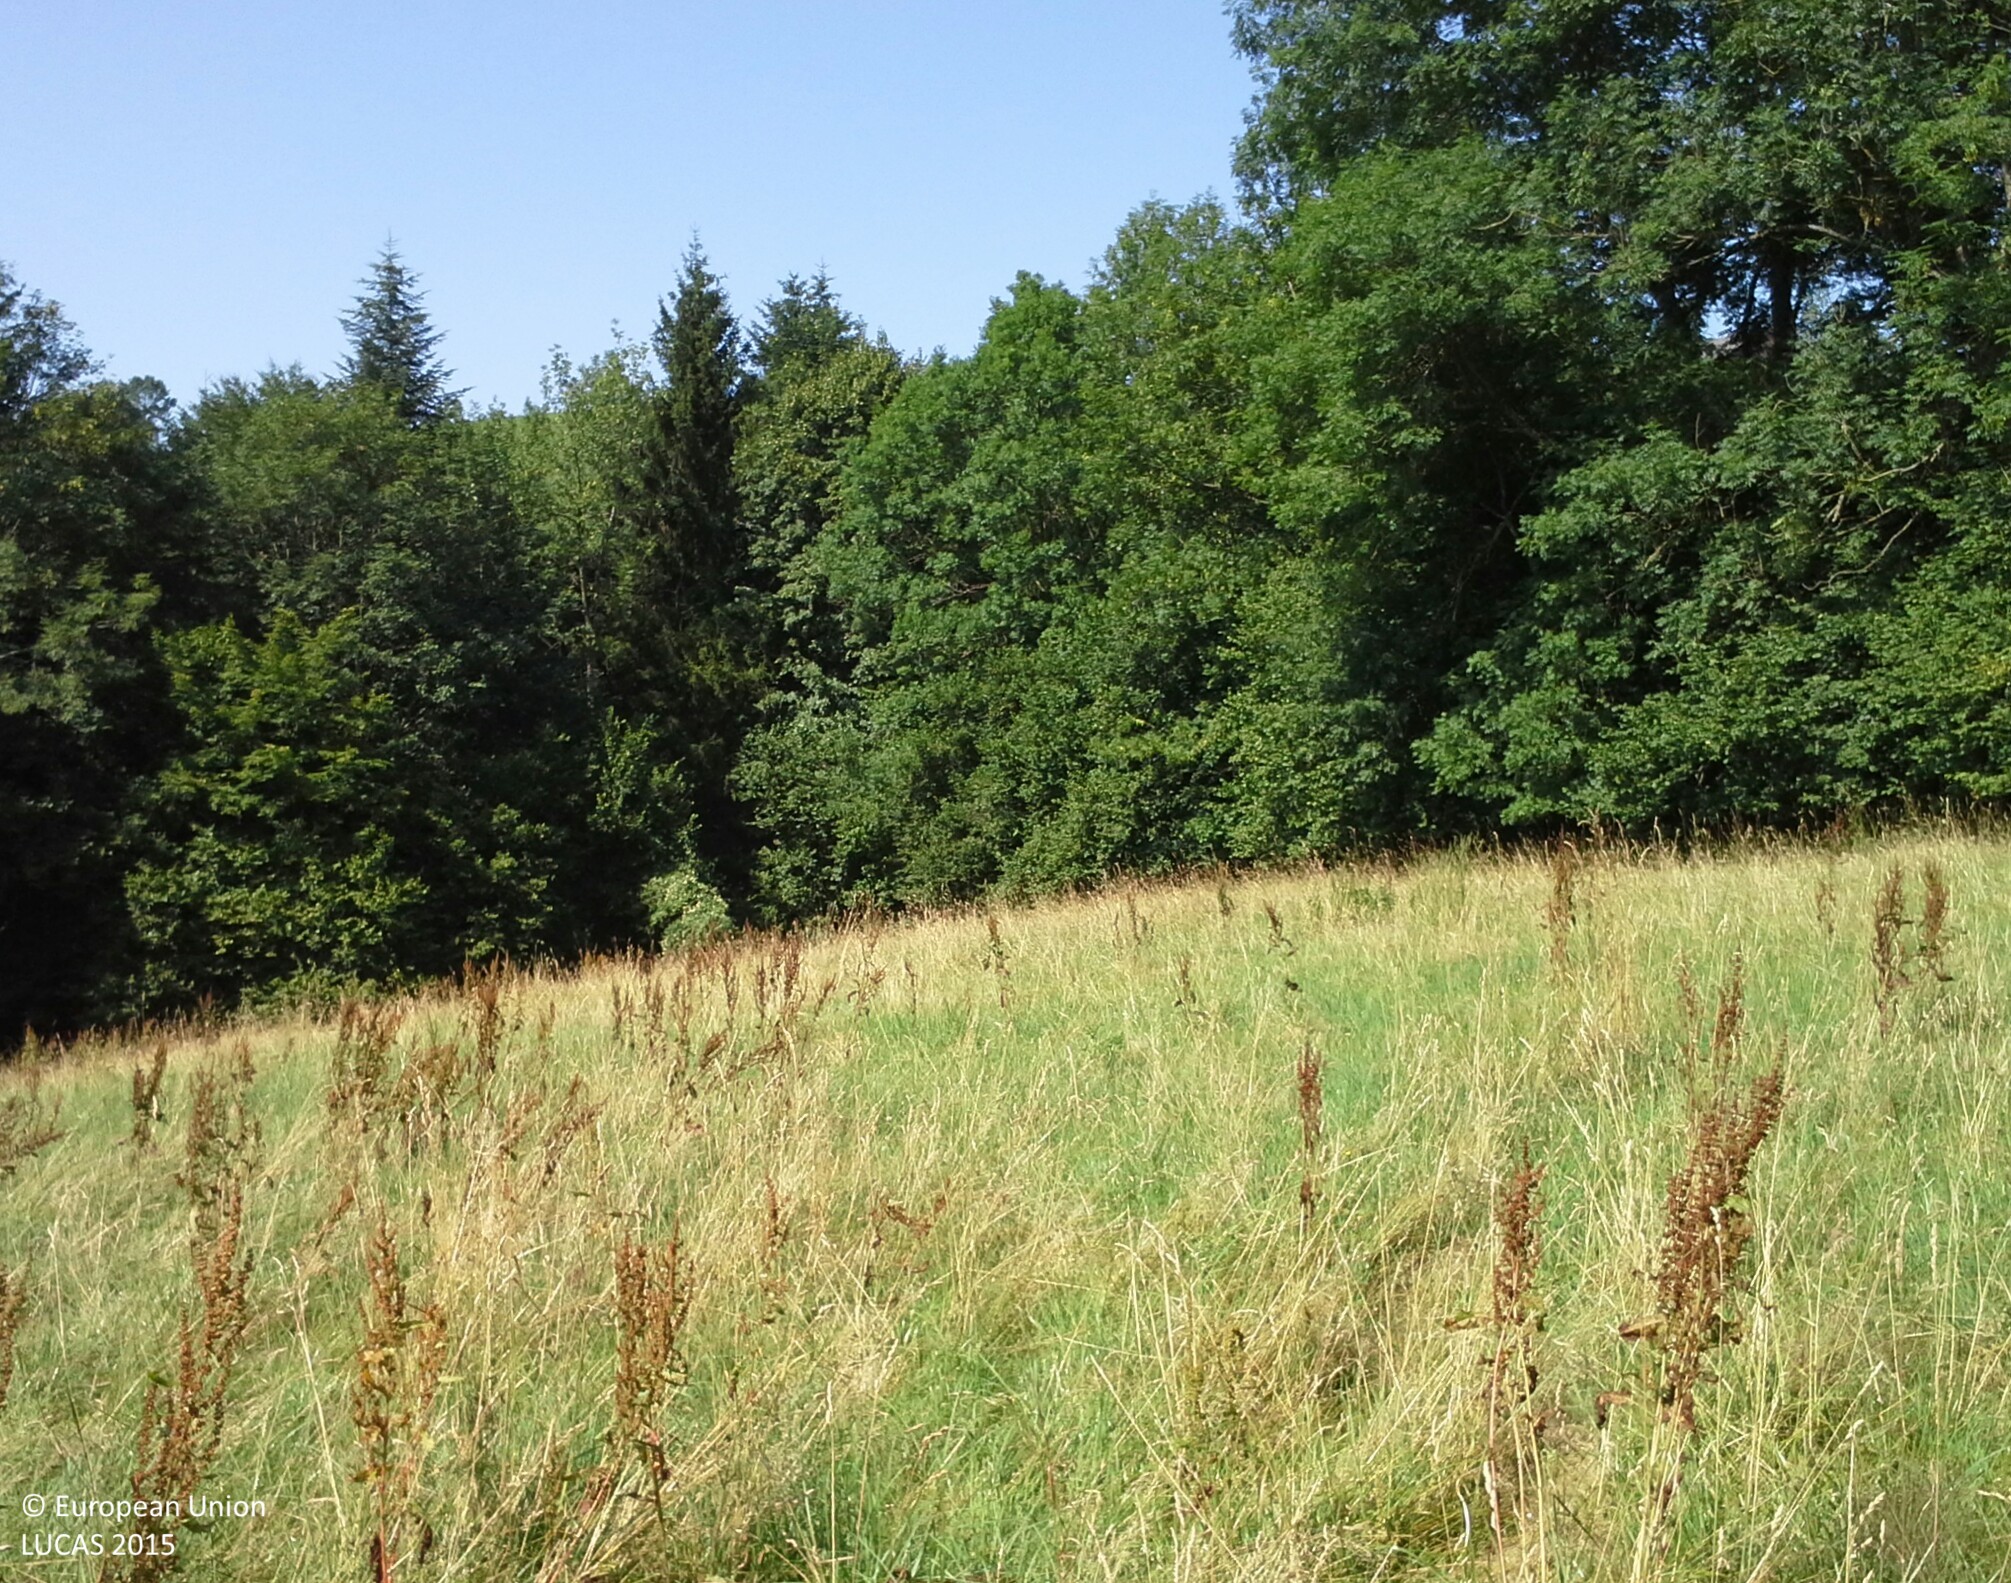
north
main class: Grassland
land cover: Grassland without tree/shrub cover
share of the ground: > 75 %
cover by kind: herbaceous plants 100 %
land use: Agriculture (excluding fallow land and kitchen gardens)
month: July
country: AT
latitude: 47.9553
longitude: 14.8346
